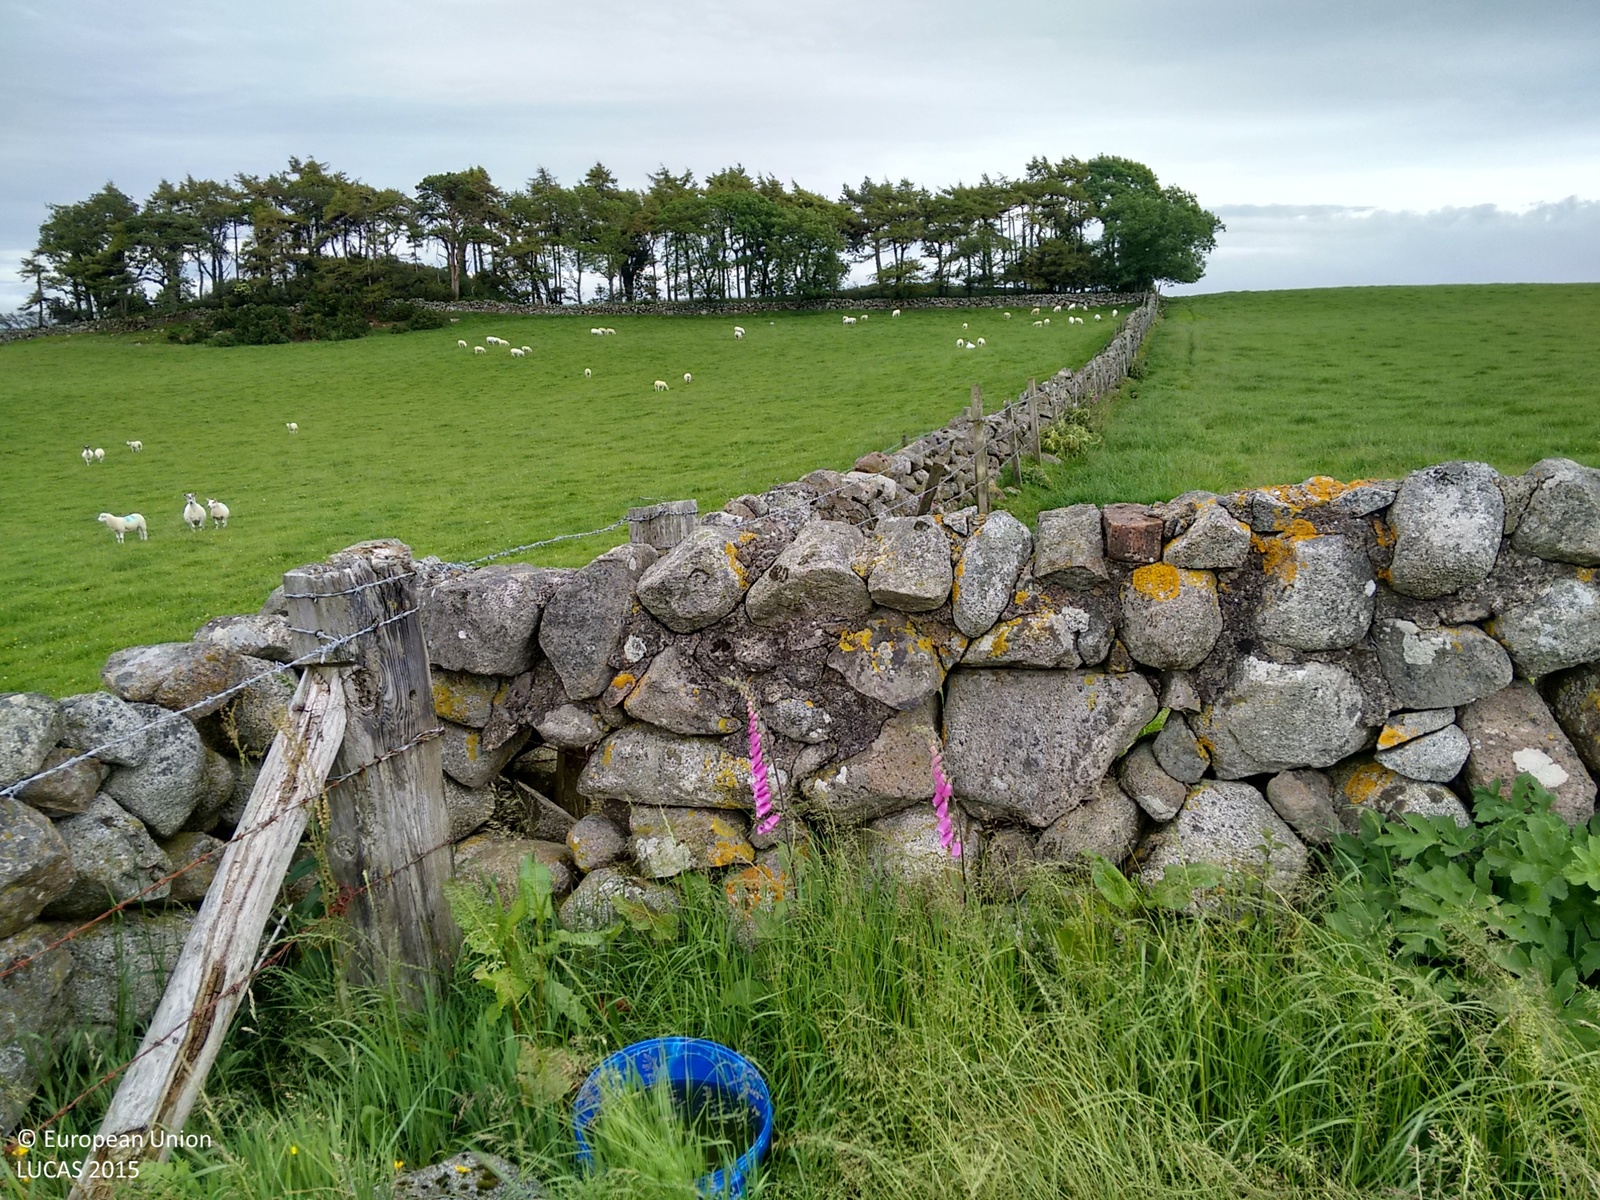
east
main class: Grassland
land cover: Grassland without tree/shrub cover
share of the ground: > 75 %
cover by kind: herbaceous plants 100 %
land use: Agriculture (excluding fallow land and kitchen gardens)
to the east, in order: Grassland without tree/shrub cover; Dry stone walls; Fences; Other mixed woodland; Dry stone walls; Fences; Grassland without tree/shrub cover
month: July
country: GB
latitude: 54.9667
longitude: -3.5939
